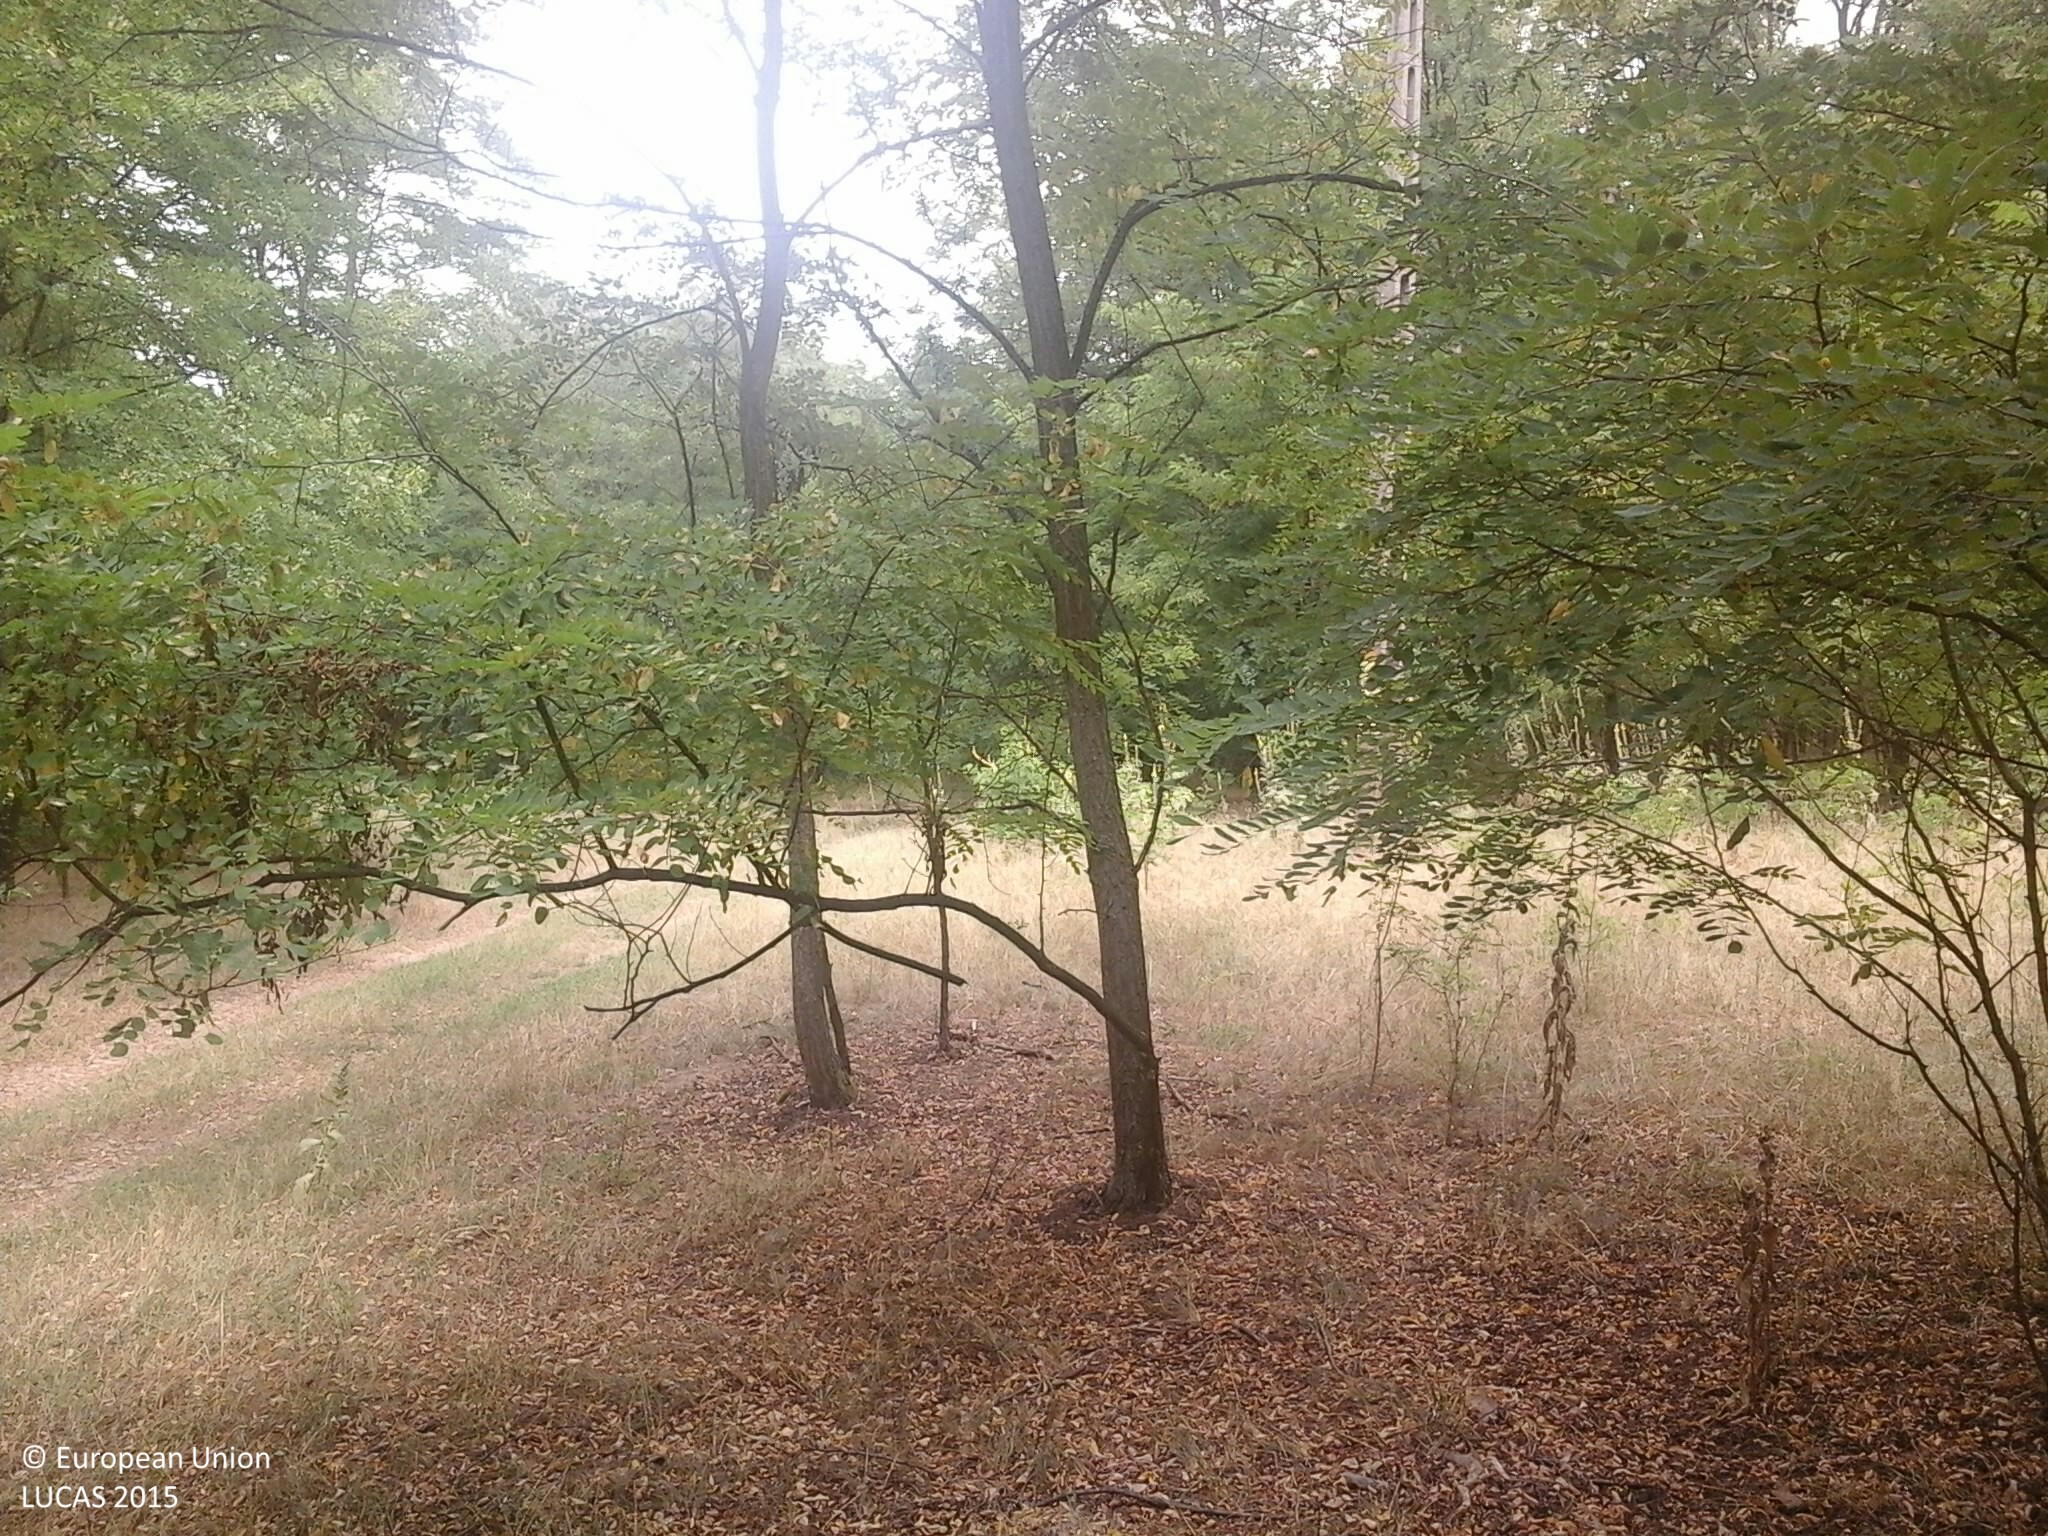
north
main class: Woodland
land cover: Broadleaved woodland
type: exotic forest
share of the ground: > 75 %
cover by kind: broadleaved forest trees 95 %, herbaceous plants 5 %
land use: Forestry
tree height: > 5 m
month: July
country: HU
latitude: 47.7546
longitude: 22.0980
